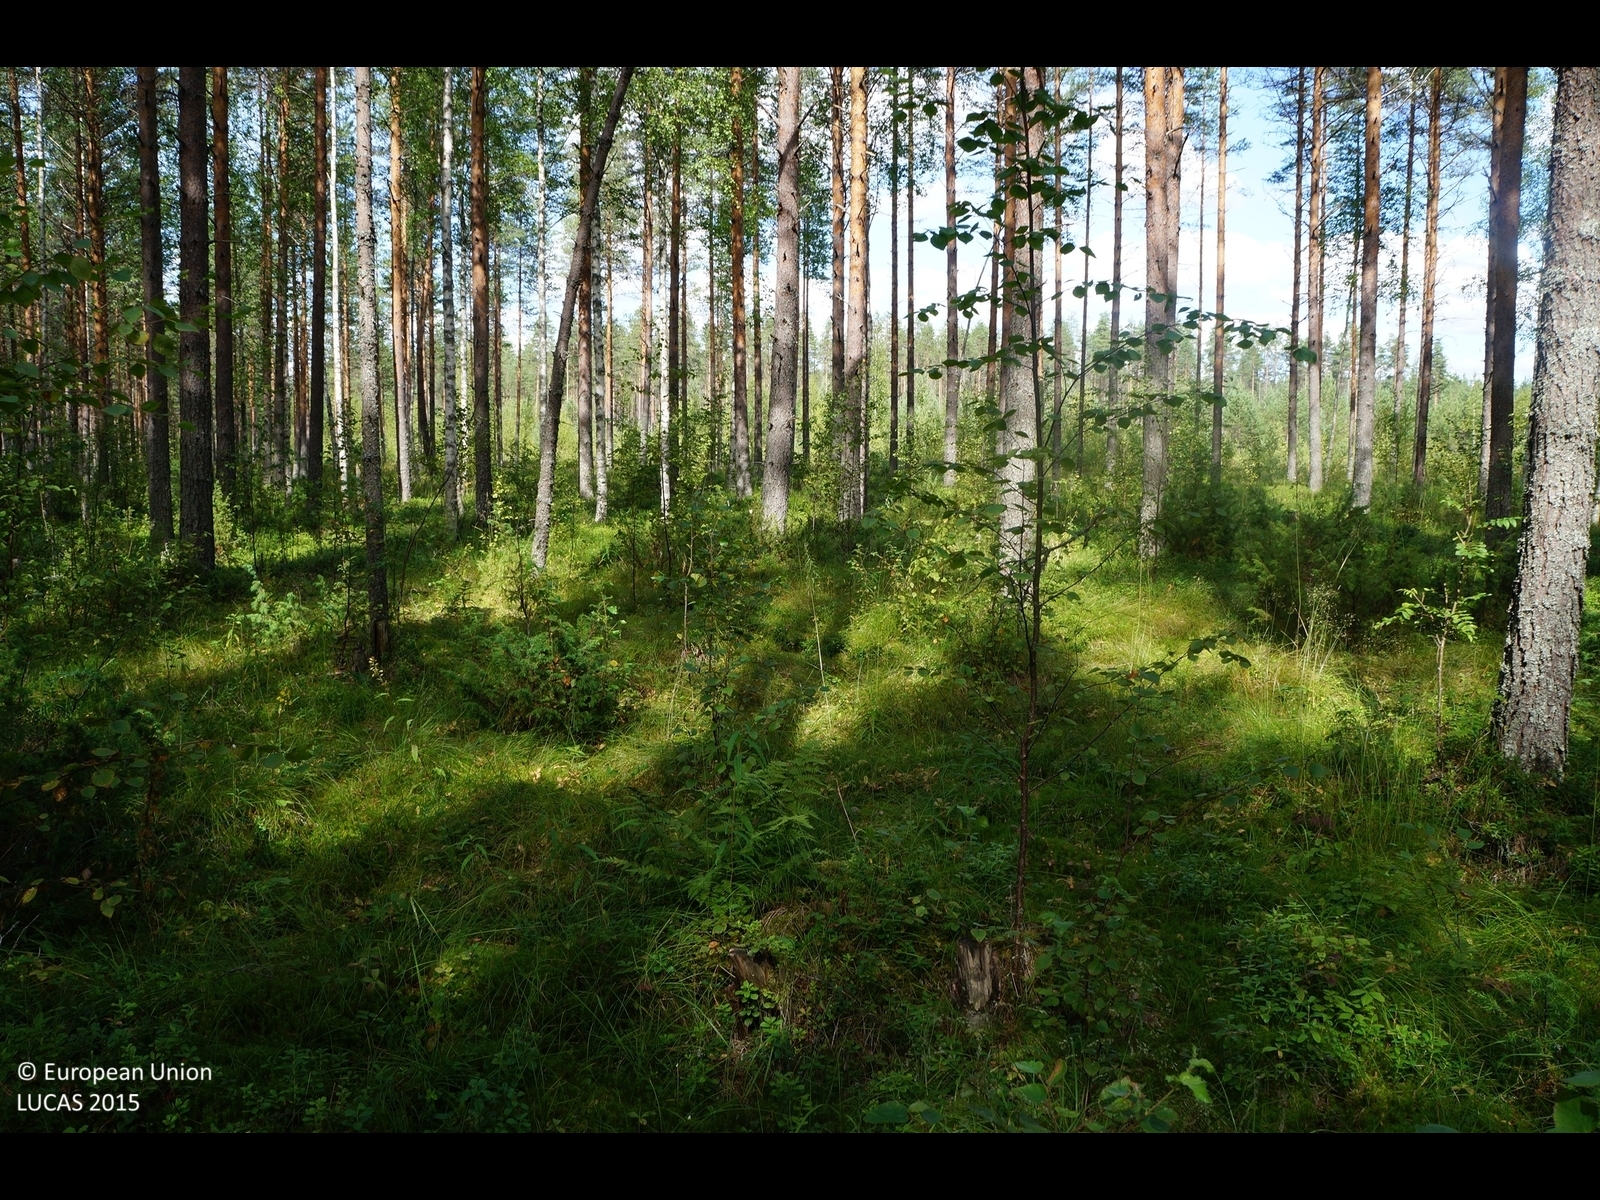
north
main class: Woodland
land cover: Pine dominated coniferous woodland
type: boreal forest
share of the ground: 50 - 75 %
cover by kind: coniferous forest trees 55 %, shrubs 20 %, lichens and mosses 15 %, herbaceous plants 10 %
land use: Forestry
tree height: > 5 m
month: August
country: FI
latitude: 64.4096
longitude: 26.0186
